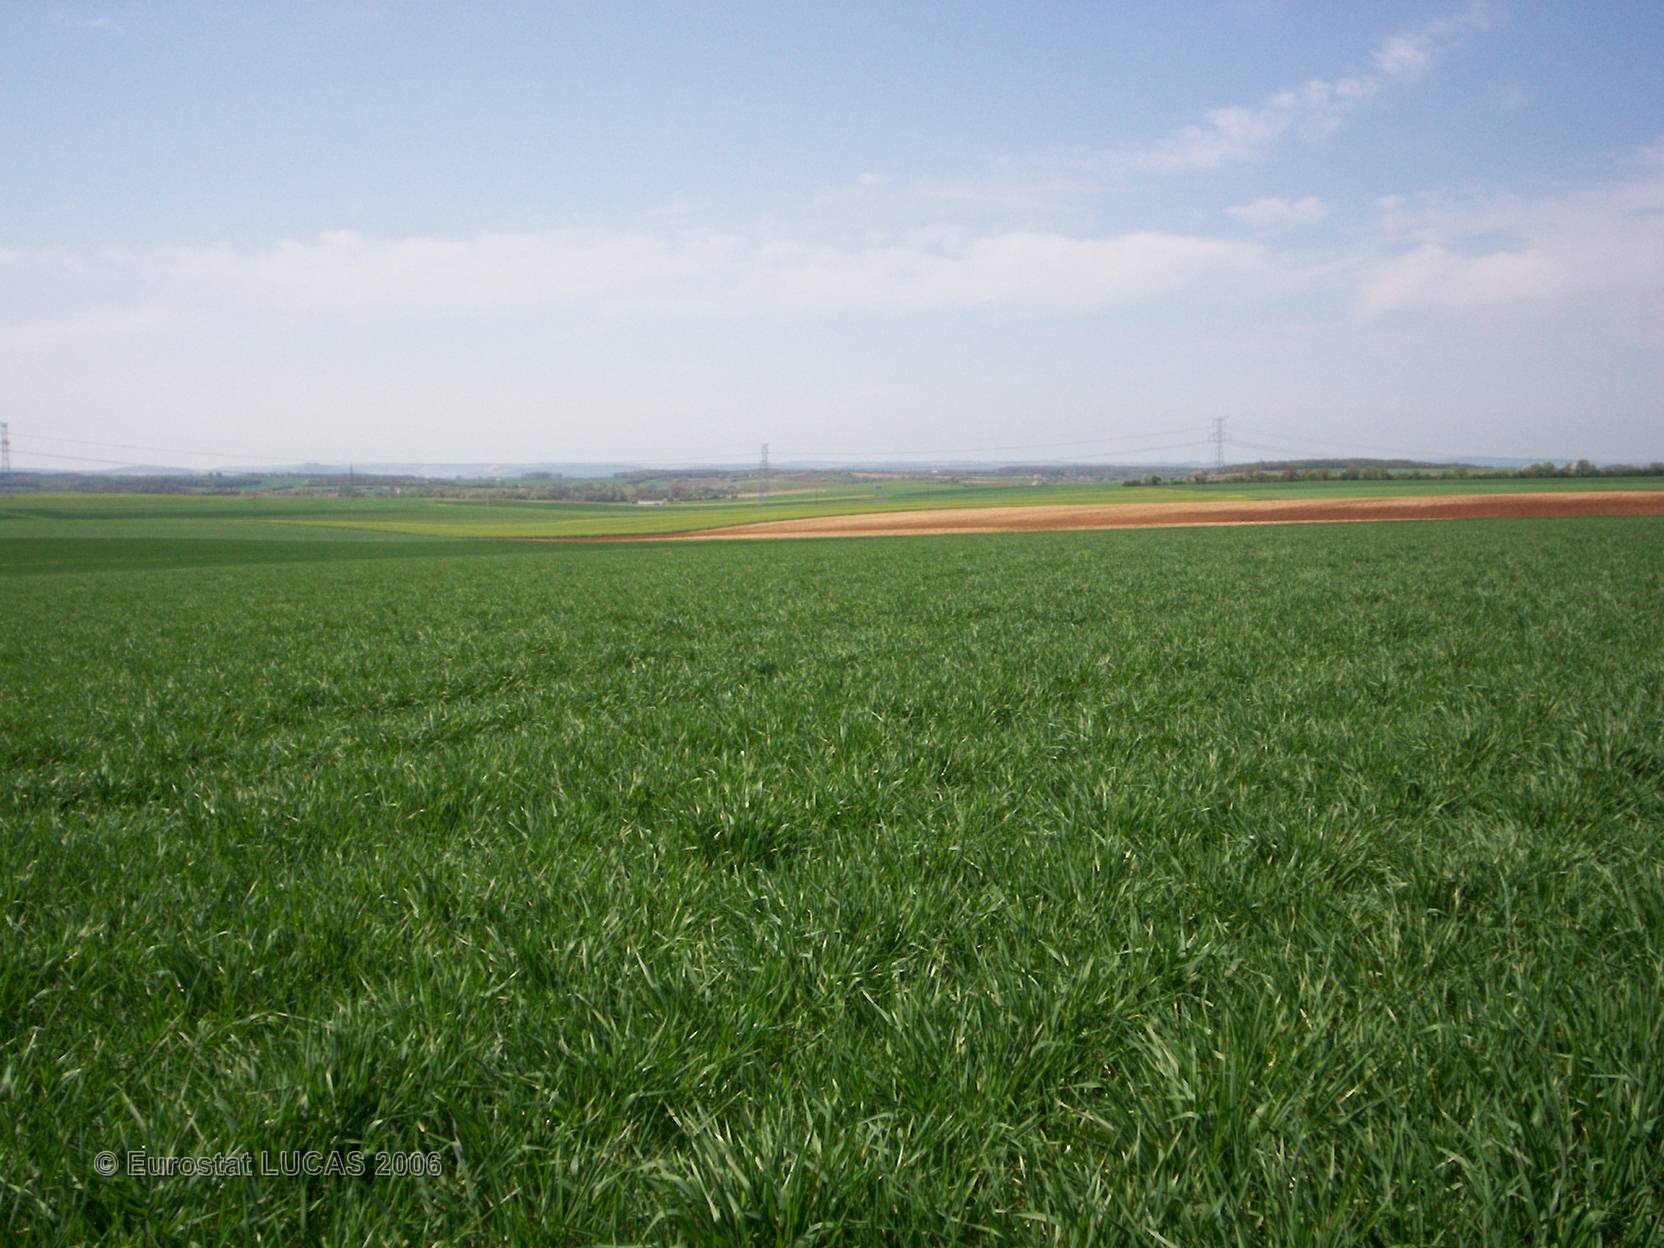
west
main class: Cropland
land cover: Common wheat
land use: Agriculture (excluding fallow land and kitchen gardens)
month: April
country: FR
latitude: 47.3697
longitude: 3.0158
